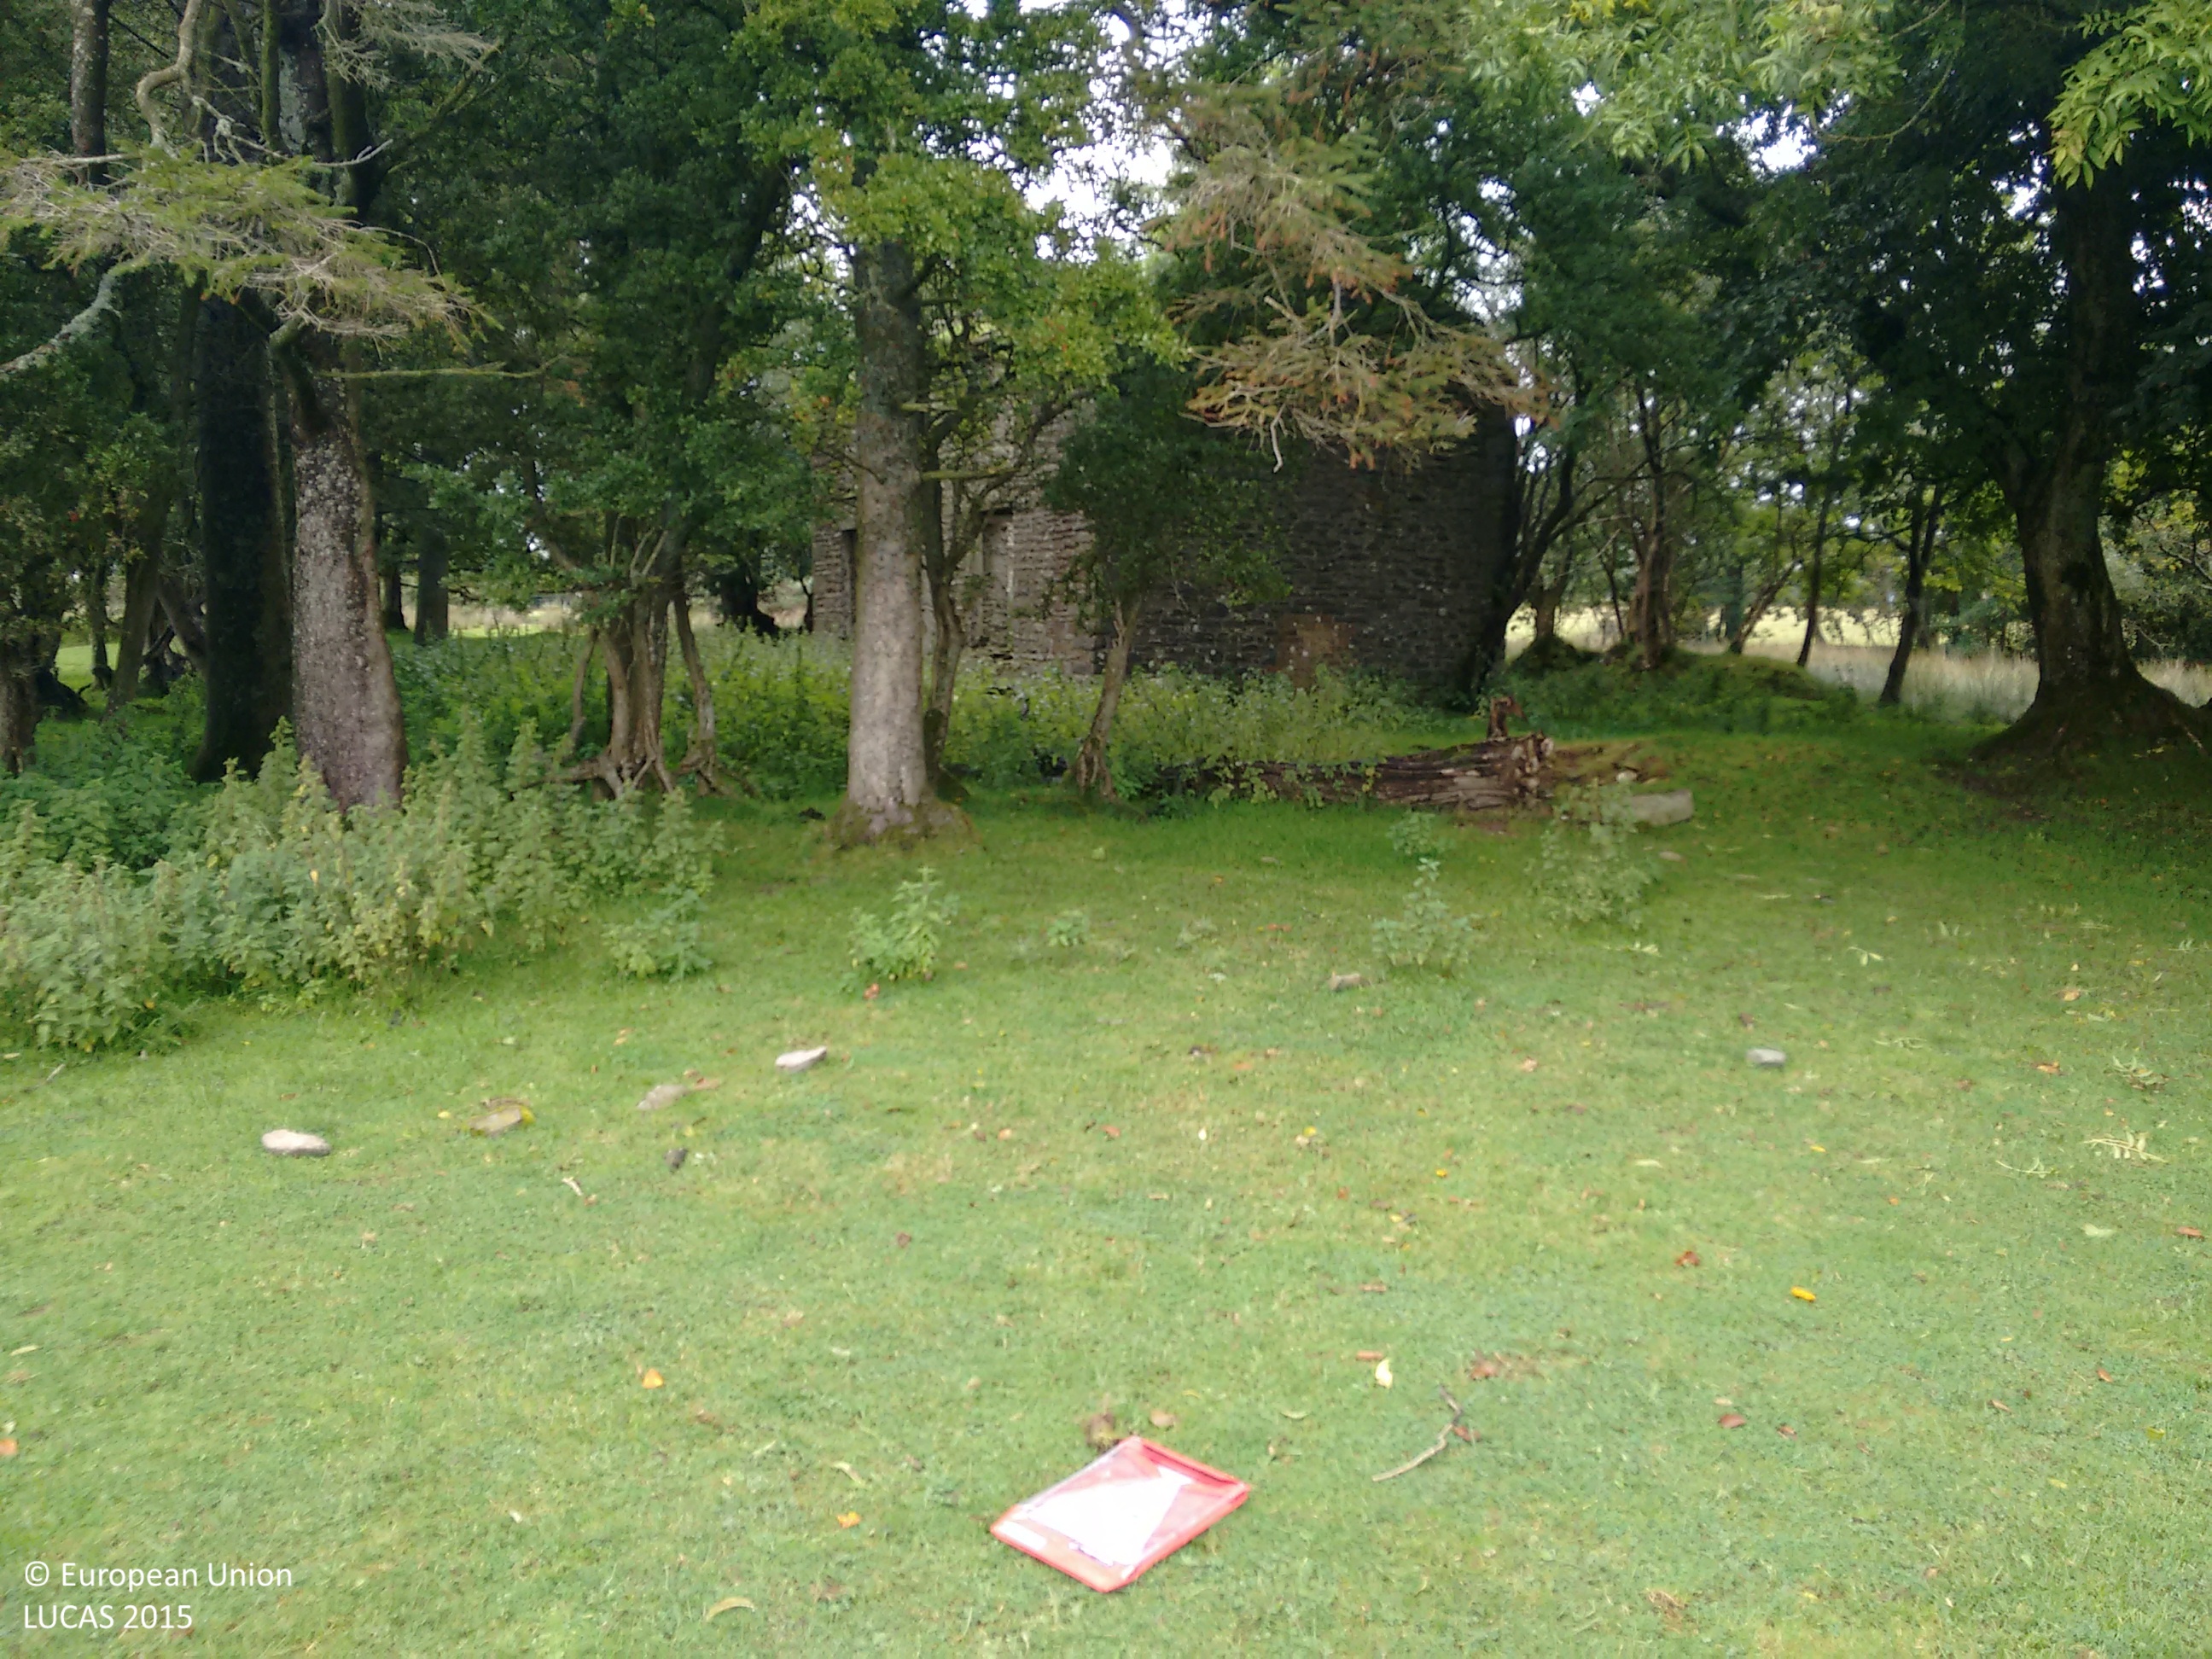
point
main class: Grassland
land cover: Grassland without tree/shrub cover
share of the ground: > 75 %
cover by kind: herbaceous plants 100 %
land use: Agriculture (excluding fallow land and kitchen gardens)
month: September
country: GB
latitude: 52.2021
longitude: -3.9799
